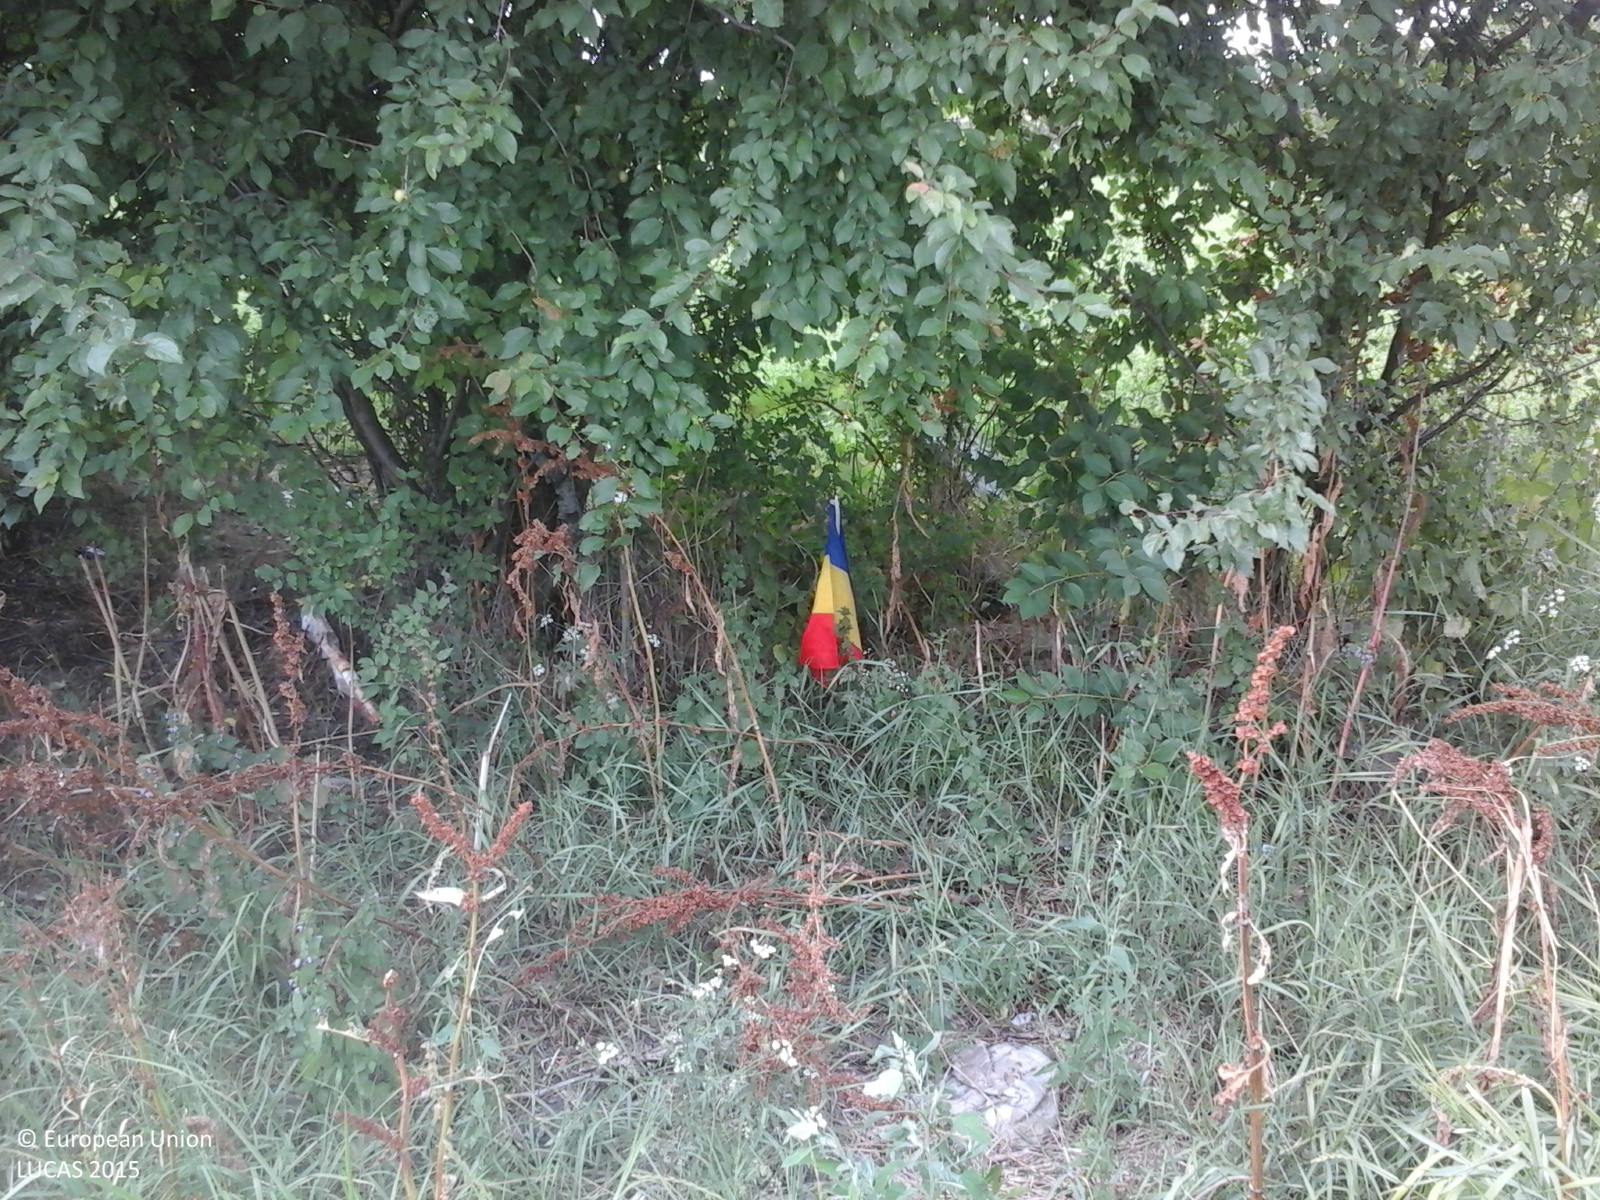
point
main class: Grassland
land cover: Grassland with sparse tree/shrub cover
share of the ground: > 75 %
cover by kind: herbaceous plants 95 %, broadleaved forest trees 5 %
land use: Agriculture (excluding fallow land and kitchen gardens)
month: June
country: RO
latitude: 44.5983
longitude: 26.2745
